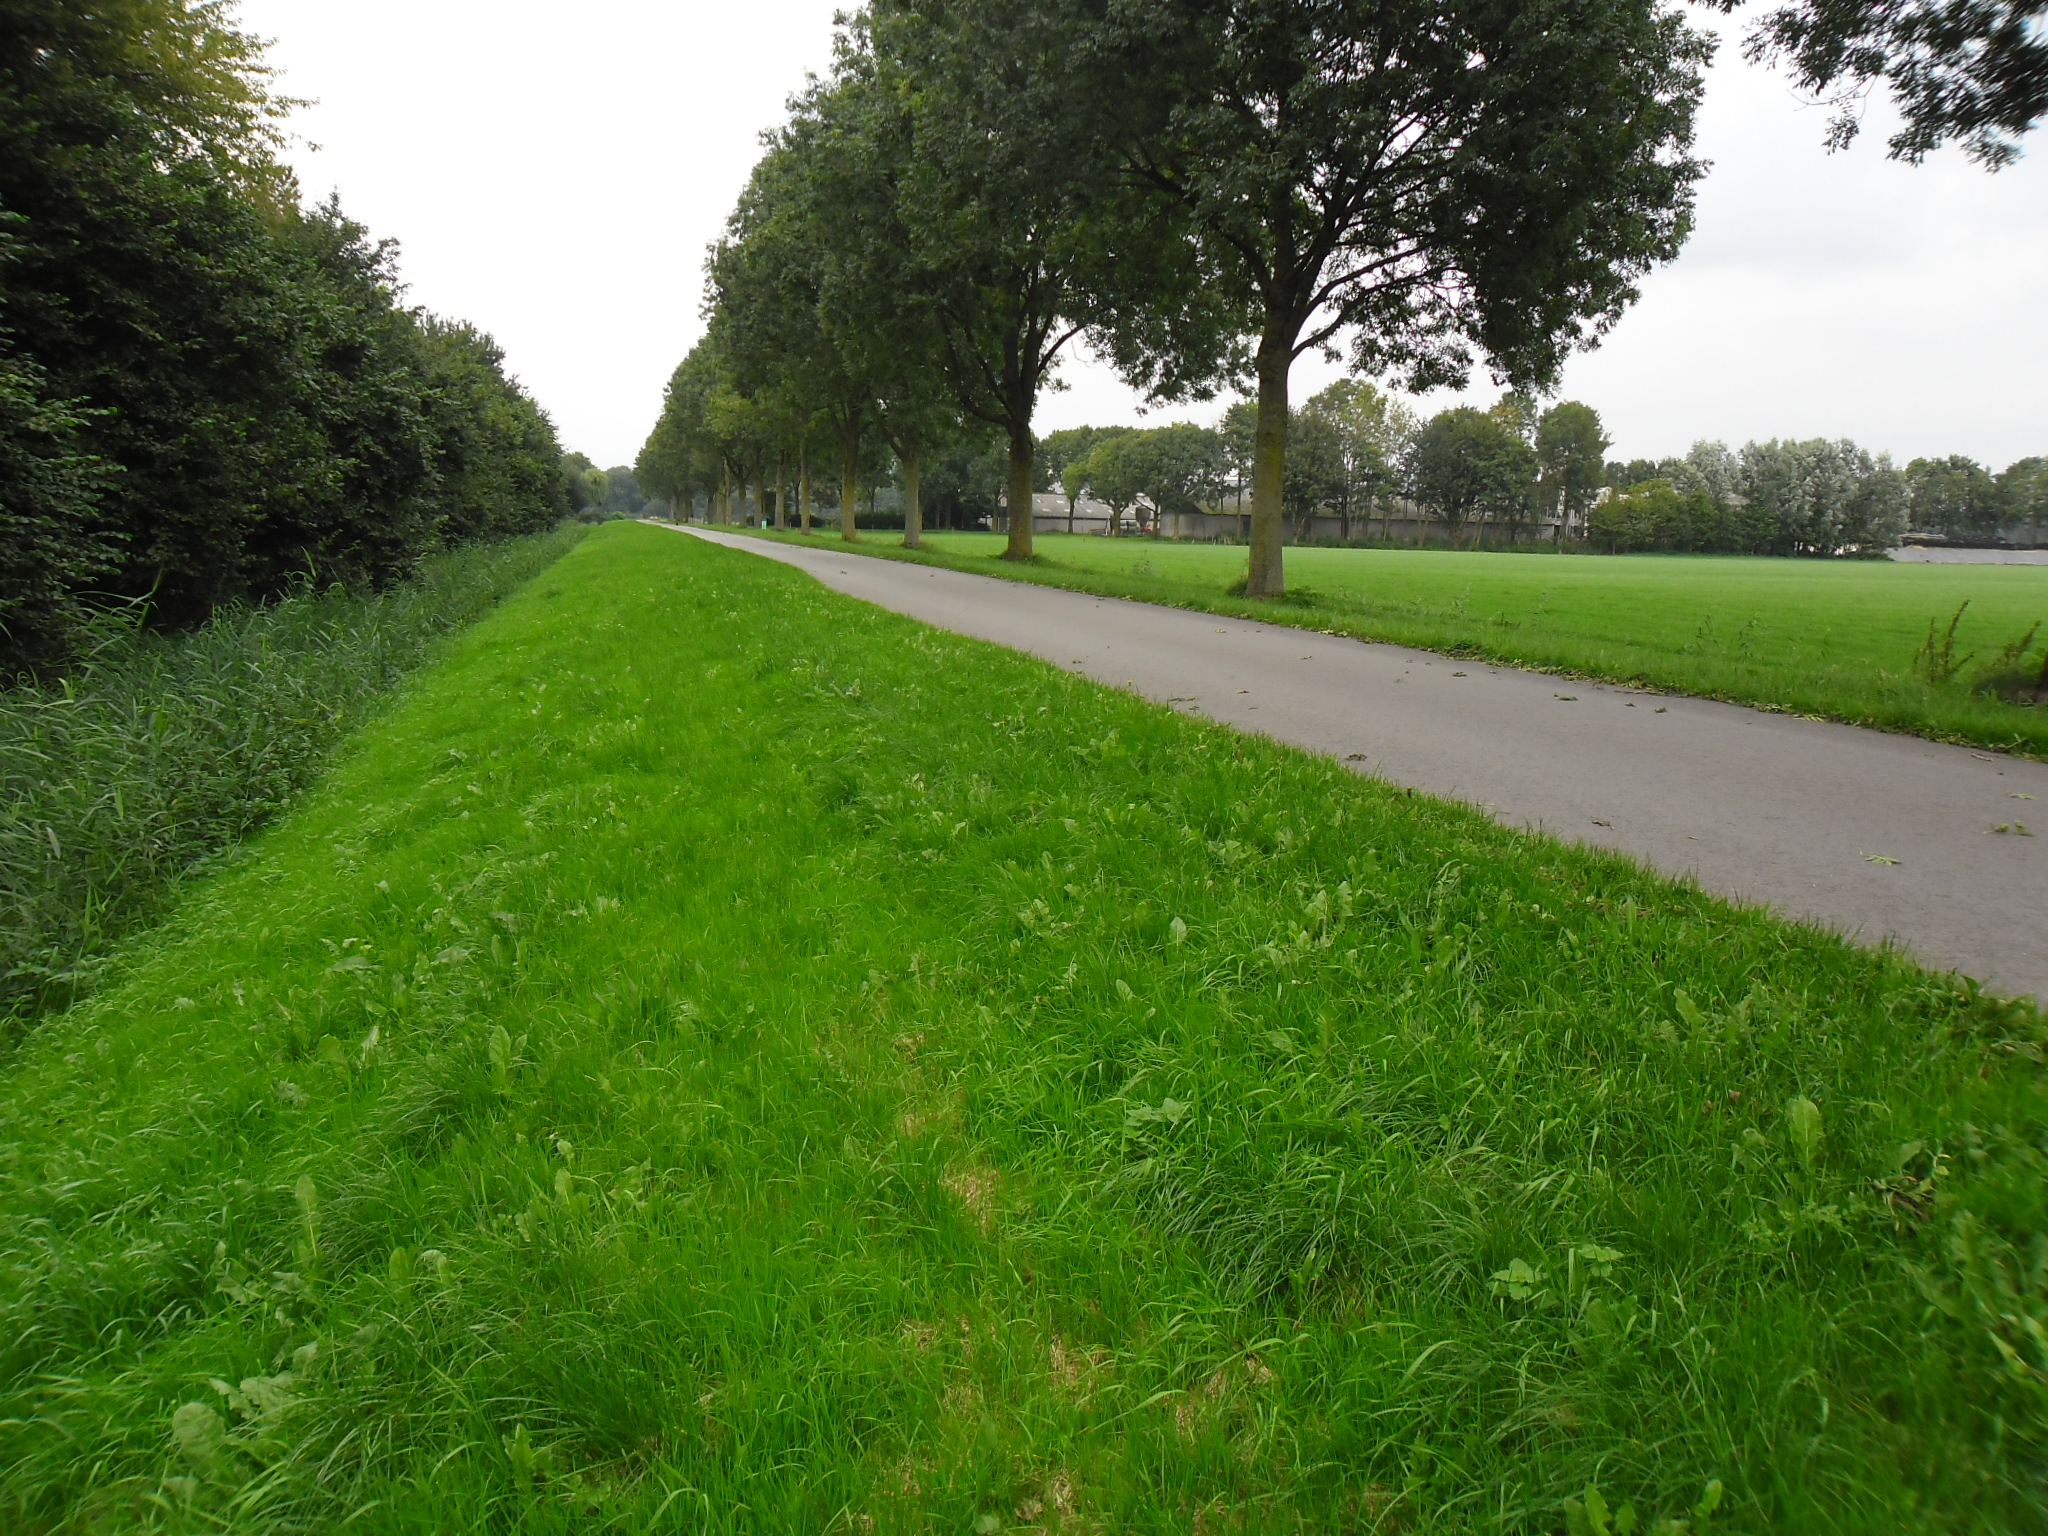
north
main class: Woodland
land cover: Broadleaved woodland
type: mesophytic deciduous forest
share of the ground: > 75 %
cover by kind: broadleaved forest trees 100 %
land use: Semi-natural and natural areas not in use
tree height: > 5 m
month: September
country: NL
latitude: 52.2742
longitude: 5.4991
